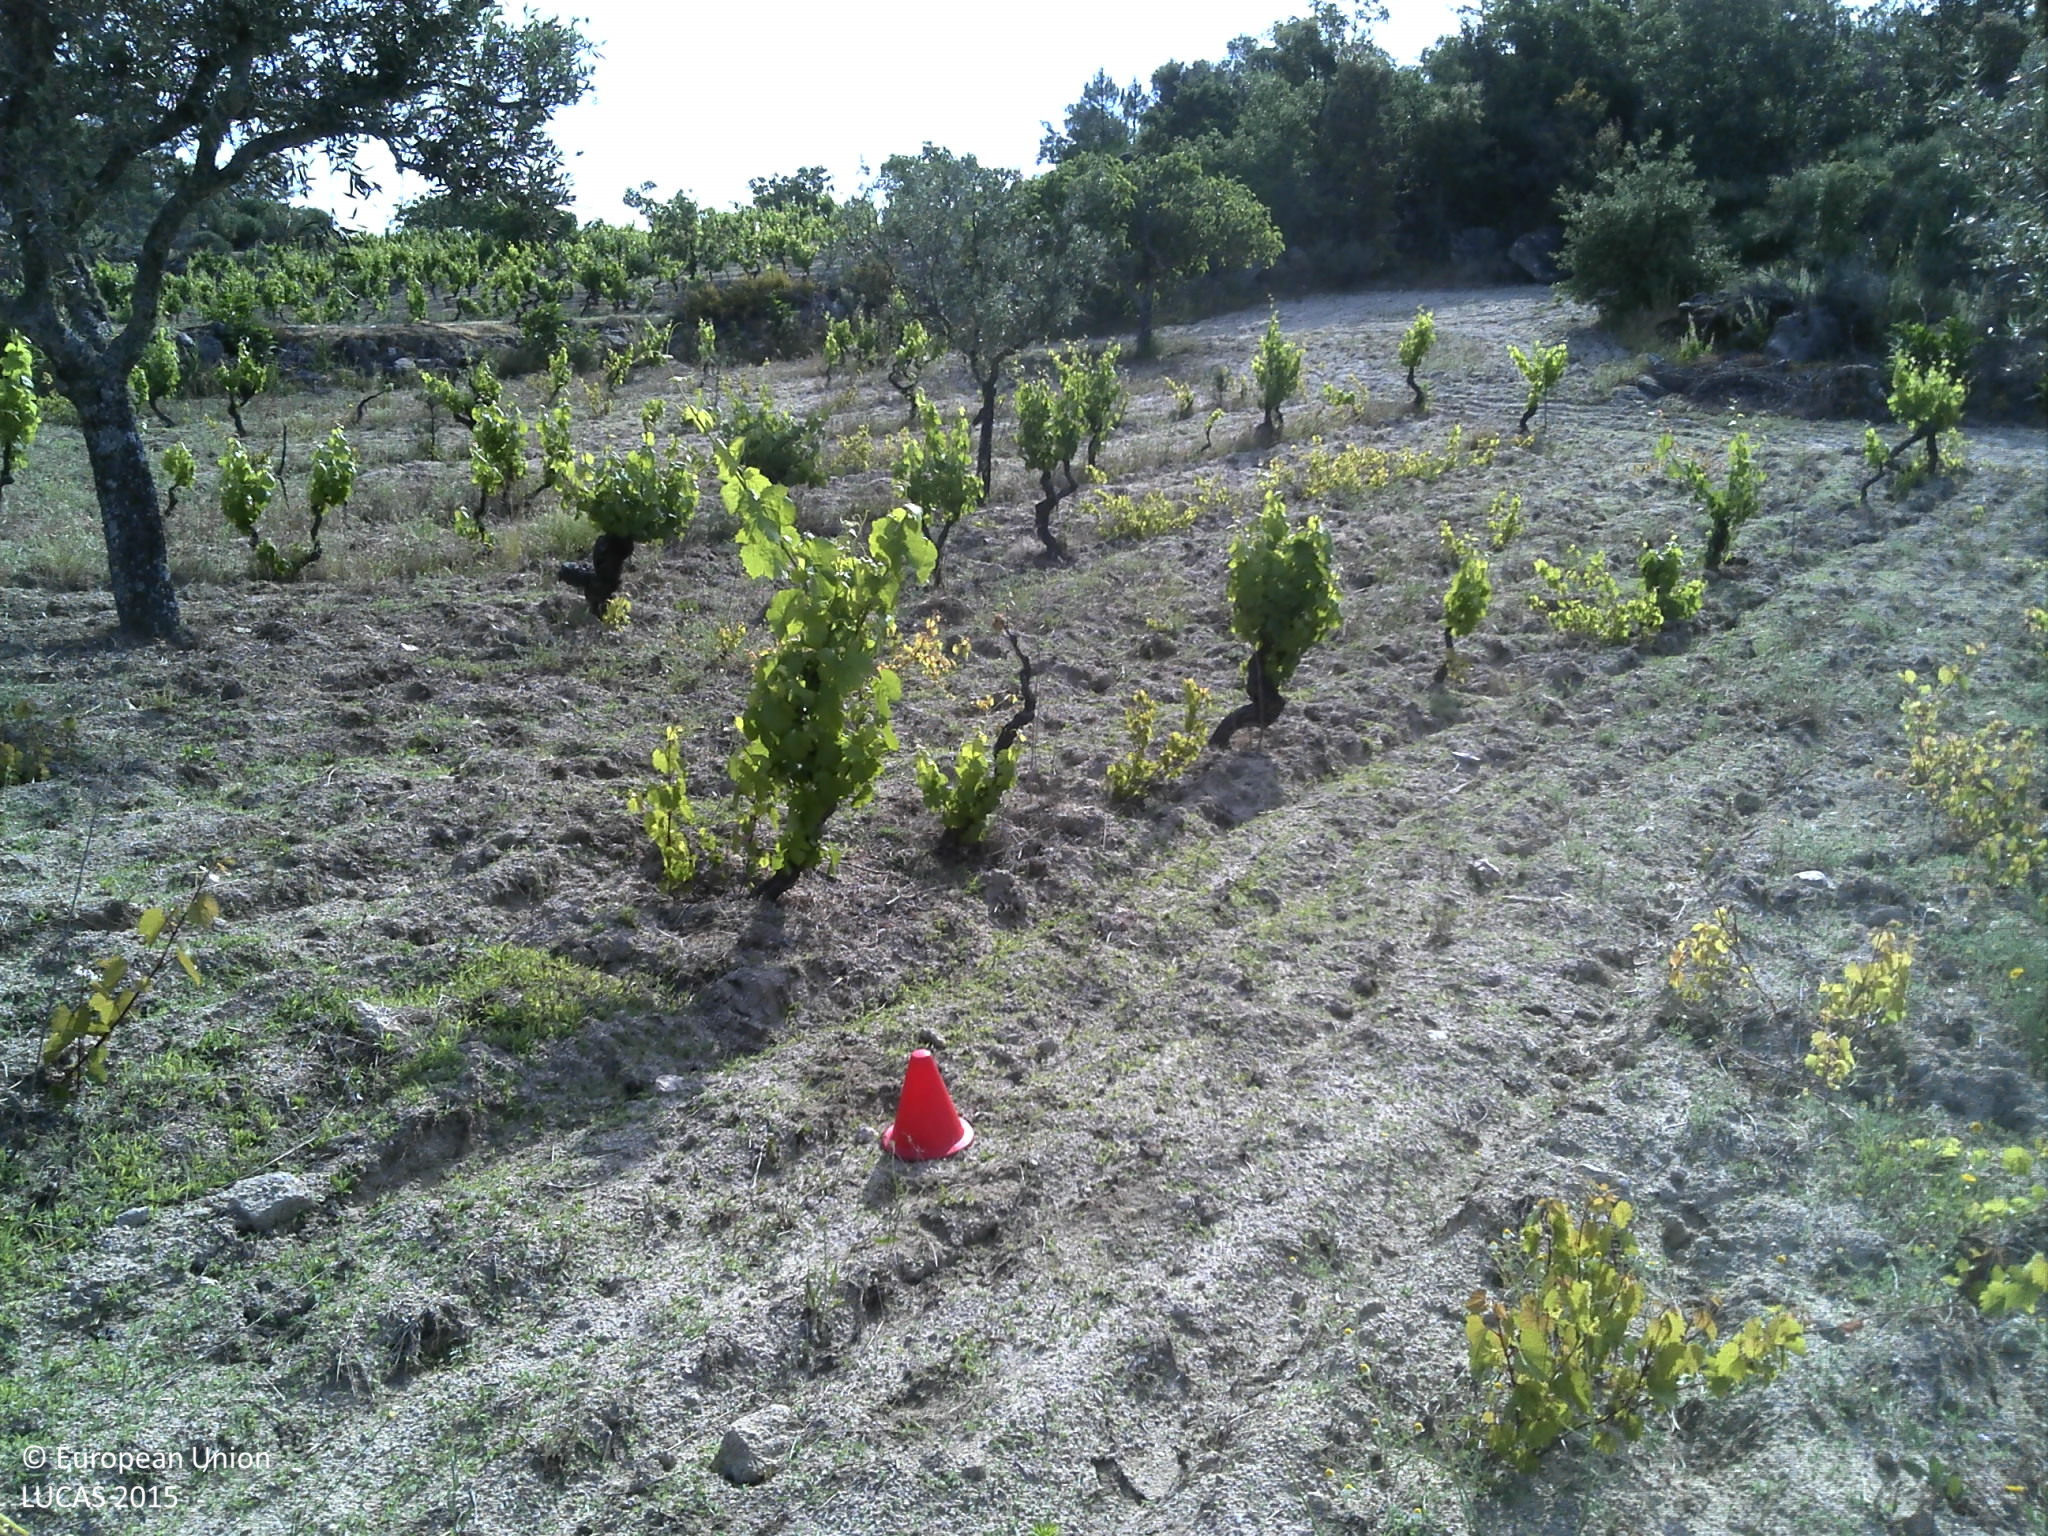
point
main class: Cropland
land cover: Vineyards
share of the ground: < 10 %
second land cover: Olive groves
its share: < 10 %
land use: Agriculture (excluding fallow land and kitchen gardens)
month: May
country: PT
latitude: 41.5783
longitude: -7.2862
